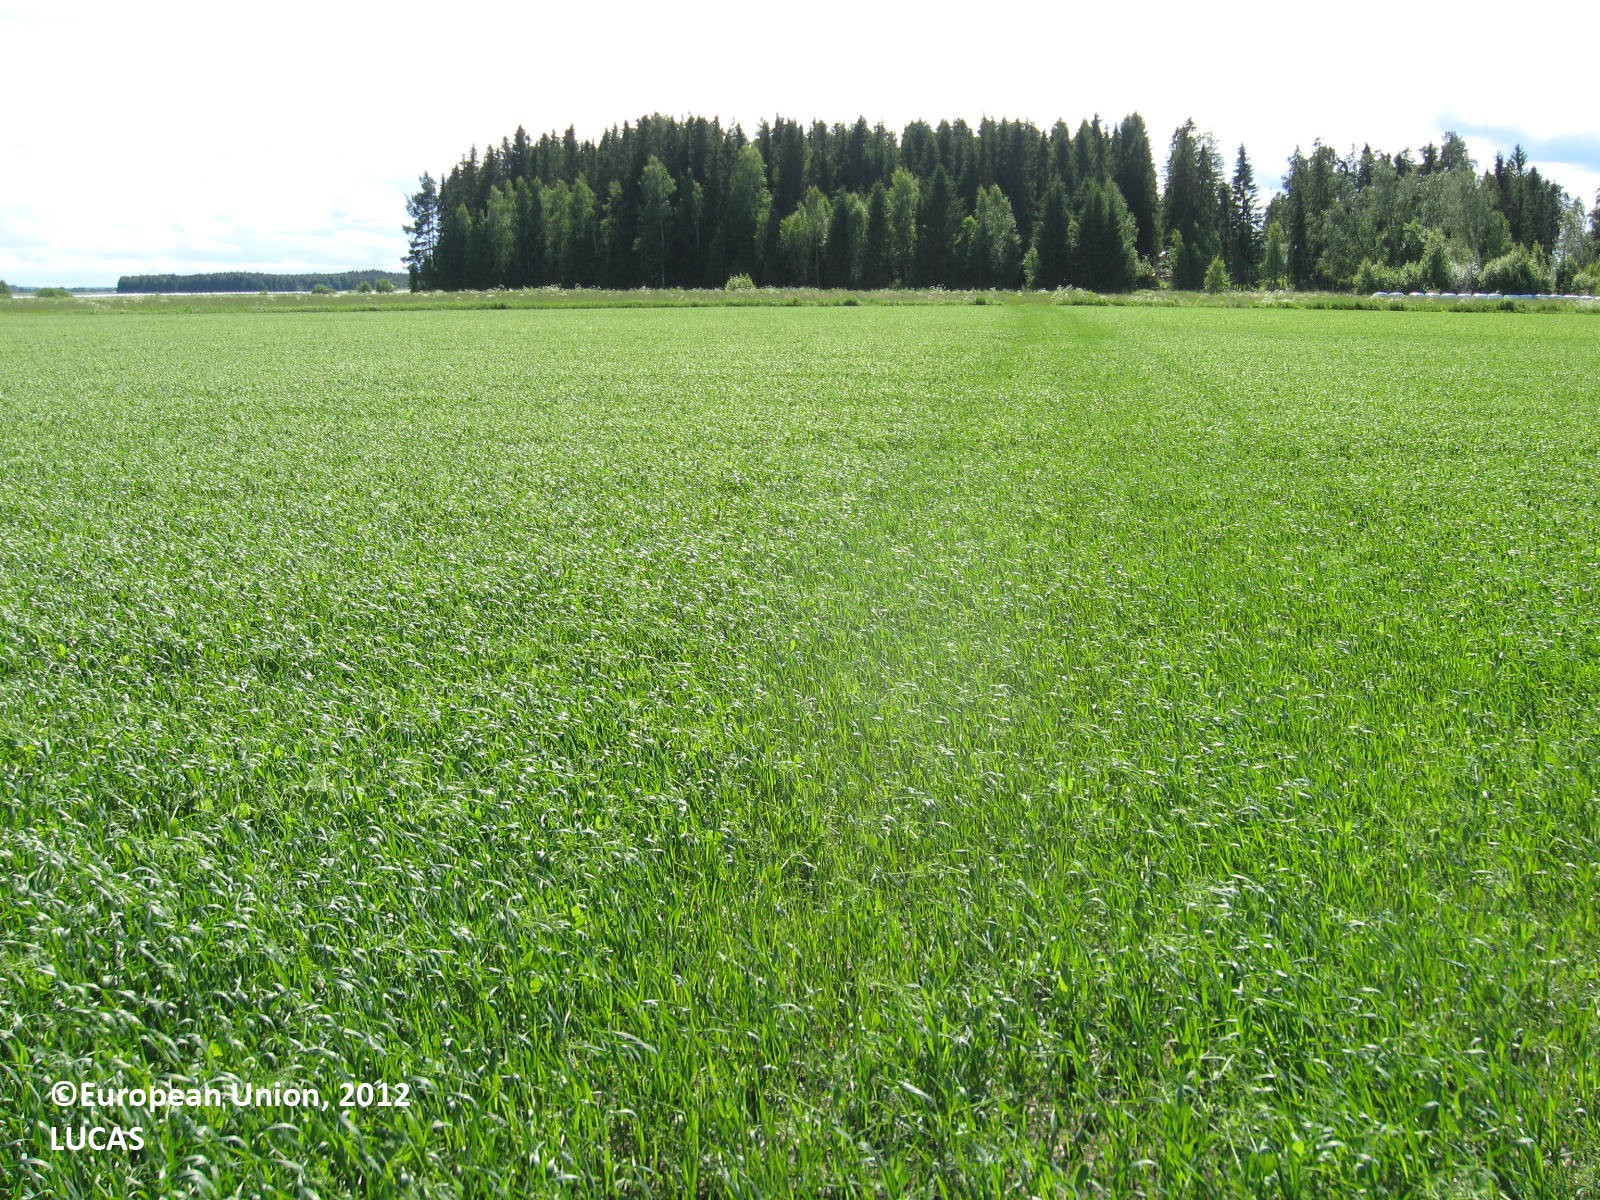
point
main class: Cropland
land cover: Temporary grasslands
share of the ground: > 75 %
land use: Agriculture (excluding fallow land and kitchen gardens)
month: June
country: FI
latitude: 62.8103
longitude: 22.6292
